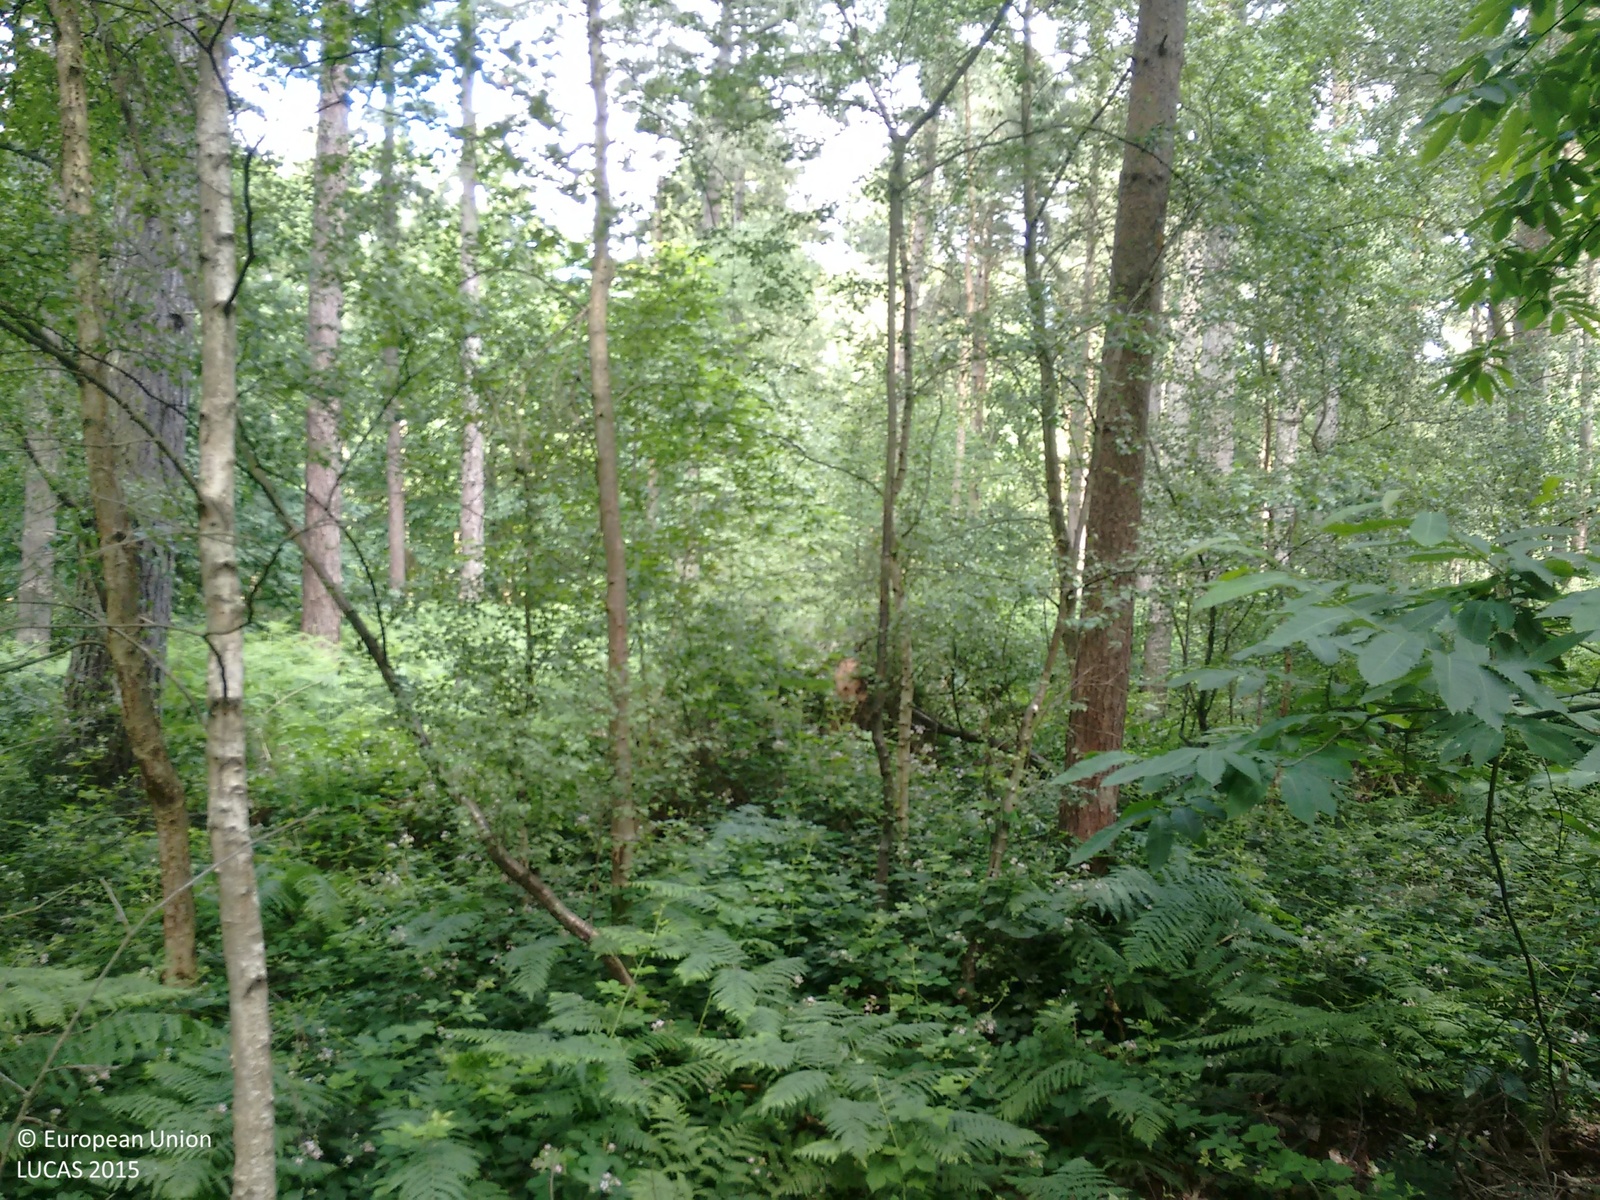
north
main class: Woodland
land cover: Pine dominated coniferous woodland
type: exotic forest
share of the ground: > 75 %
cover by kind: coniferous forest trees 90 %, broadleaved forest trees 10 %
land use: Forestry
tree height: > 5 m
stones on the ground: < 10 %
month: July
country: GB
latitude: 53.2947
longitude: -1.0413
